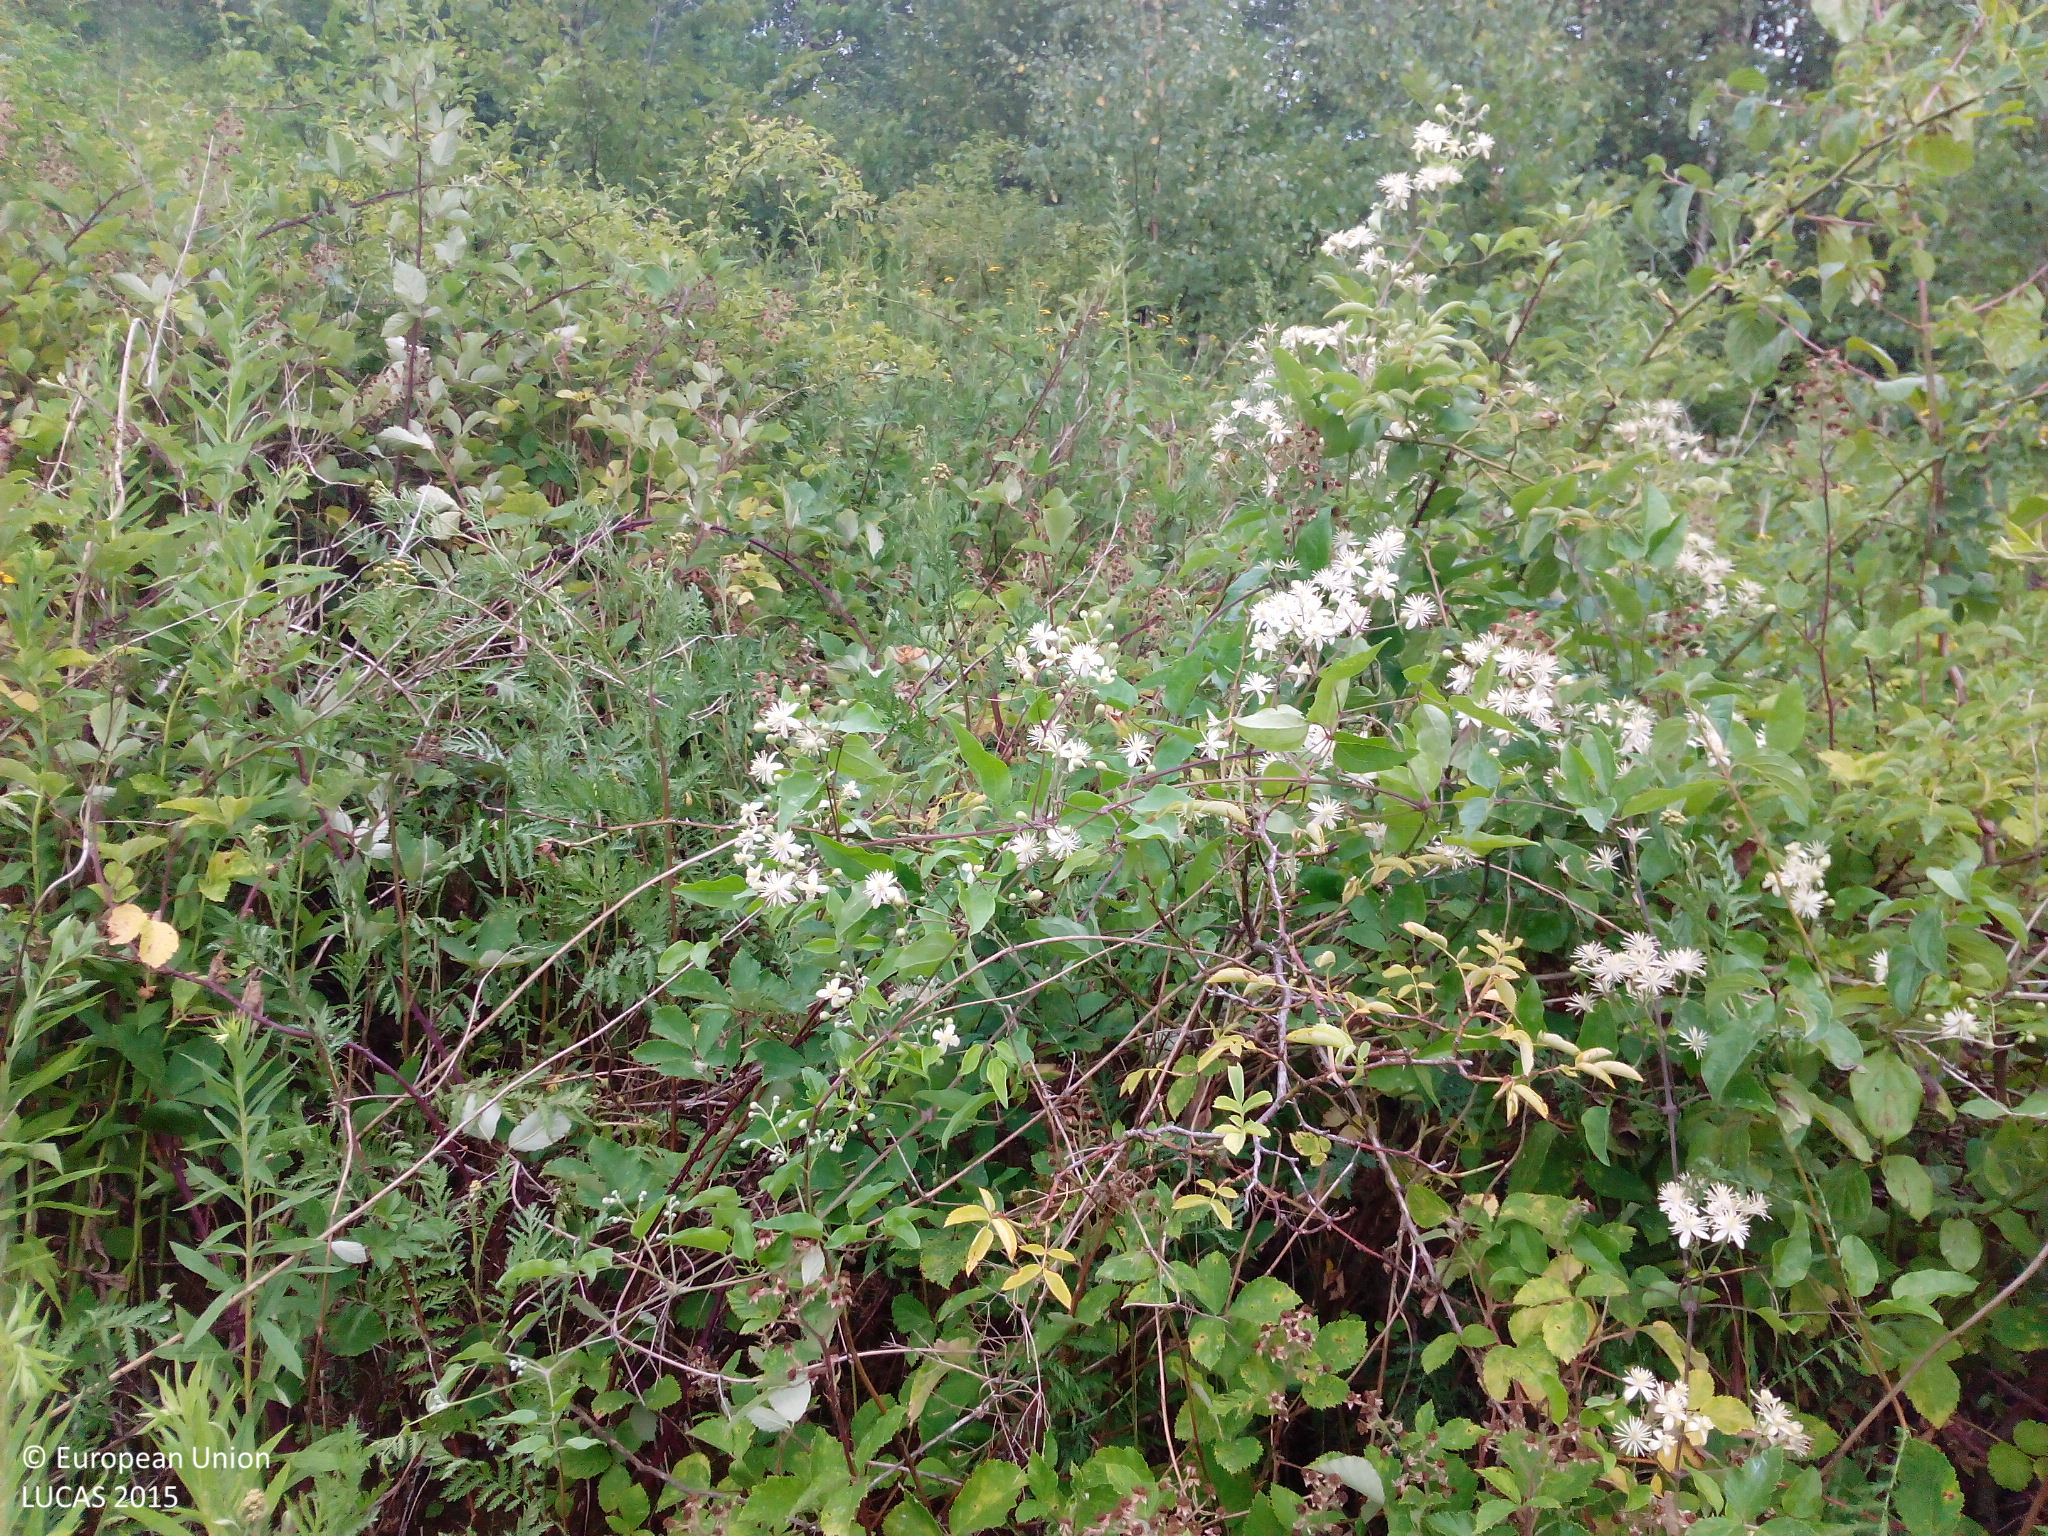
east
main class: Shrubland
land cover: Shrubland with sparse tree cover
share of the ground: > 75 %
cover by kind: shrubs 70 %, herbaceous plants 25 %, broadleaved forest trees 5 %
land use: Abandoned areas
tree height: < 5 m
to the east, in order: Shrubland with sparse tree cover; Broadleaved woodland; Tracks; Broadleaved woodland; Arable land (only in case pi); Broadleaved woodland; Tracks; Broadleaved woodland
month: July
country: DE
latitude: 49.9319
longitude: 7.1164
